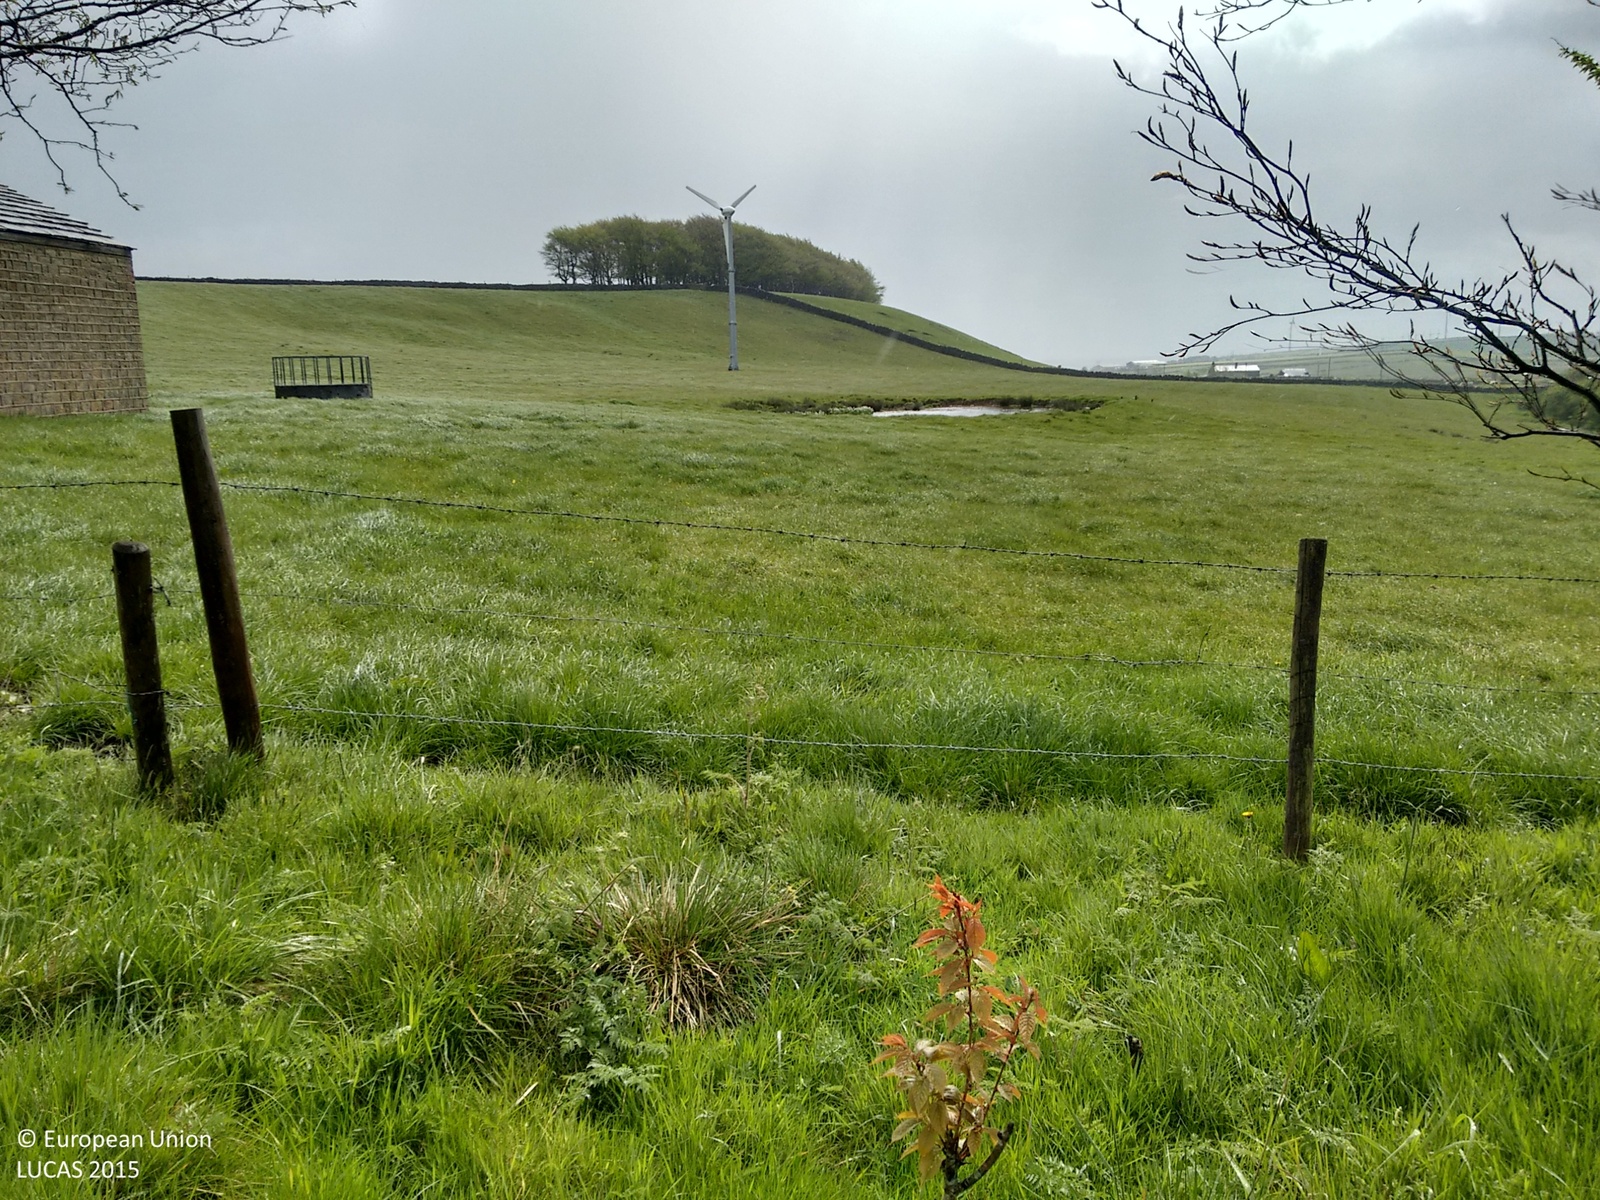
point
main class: Grassland
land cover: Grassland without tree/shrub cover
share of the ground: > 75 %
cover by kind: herbaceous plants 100 %
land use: Agriculture (excluding fallow land and kitchen gardens)
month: May
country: GB
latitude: 53.5573
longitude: -1.7223
